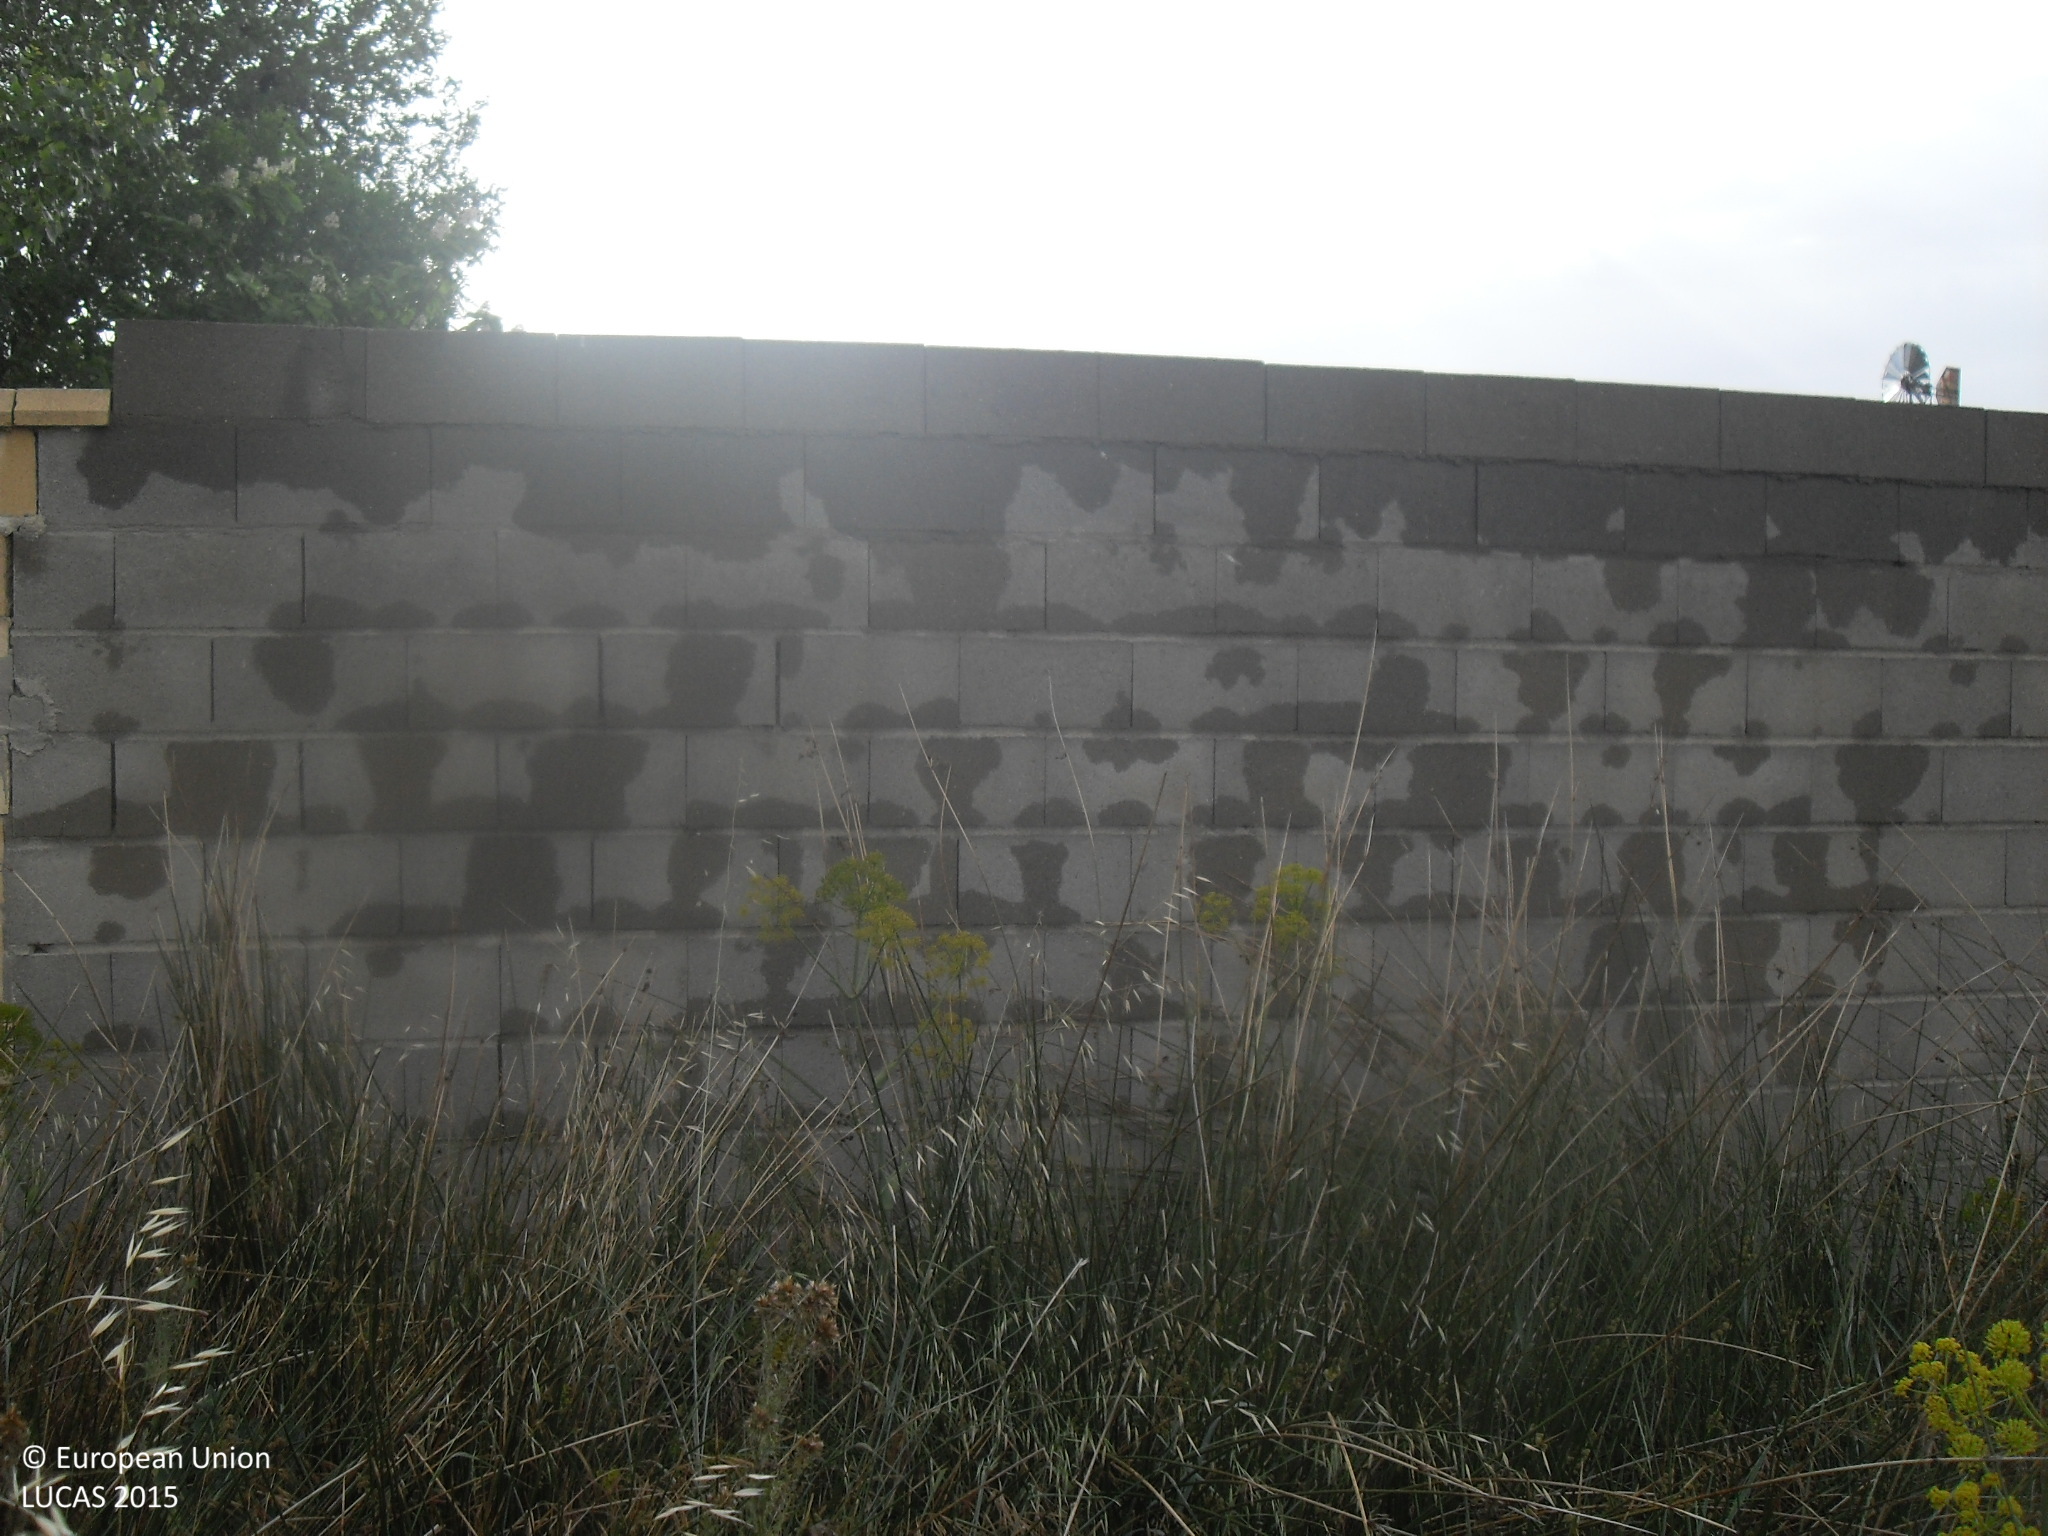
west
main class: Grassland
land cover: Spontaneously vegetated surfaces
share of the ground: > 75 %
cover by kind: herbaceous plants 100 %
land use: Abandoned areas
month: June
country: ES
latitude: 41.0179
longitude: -5.6924
